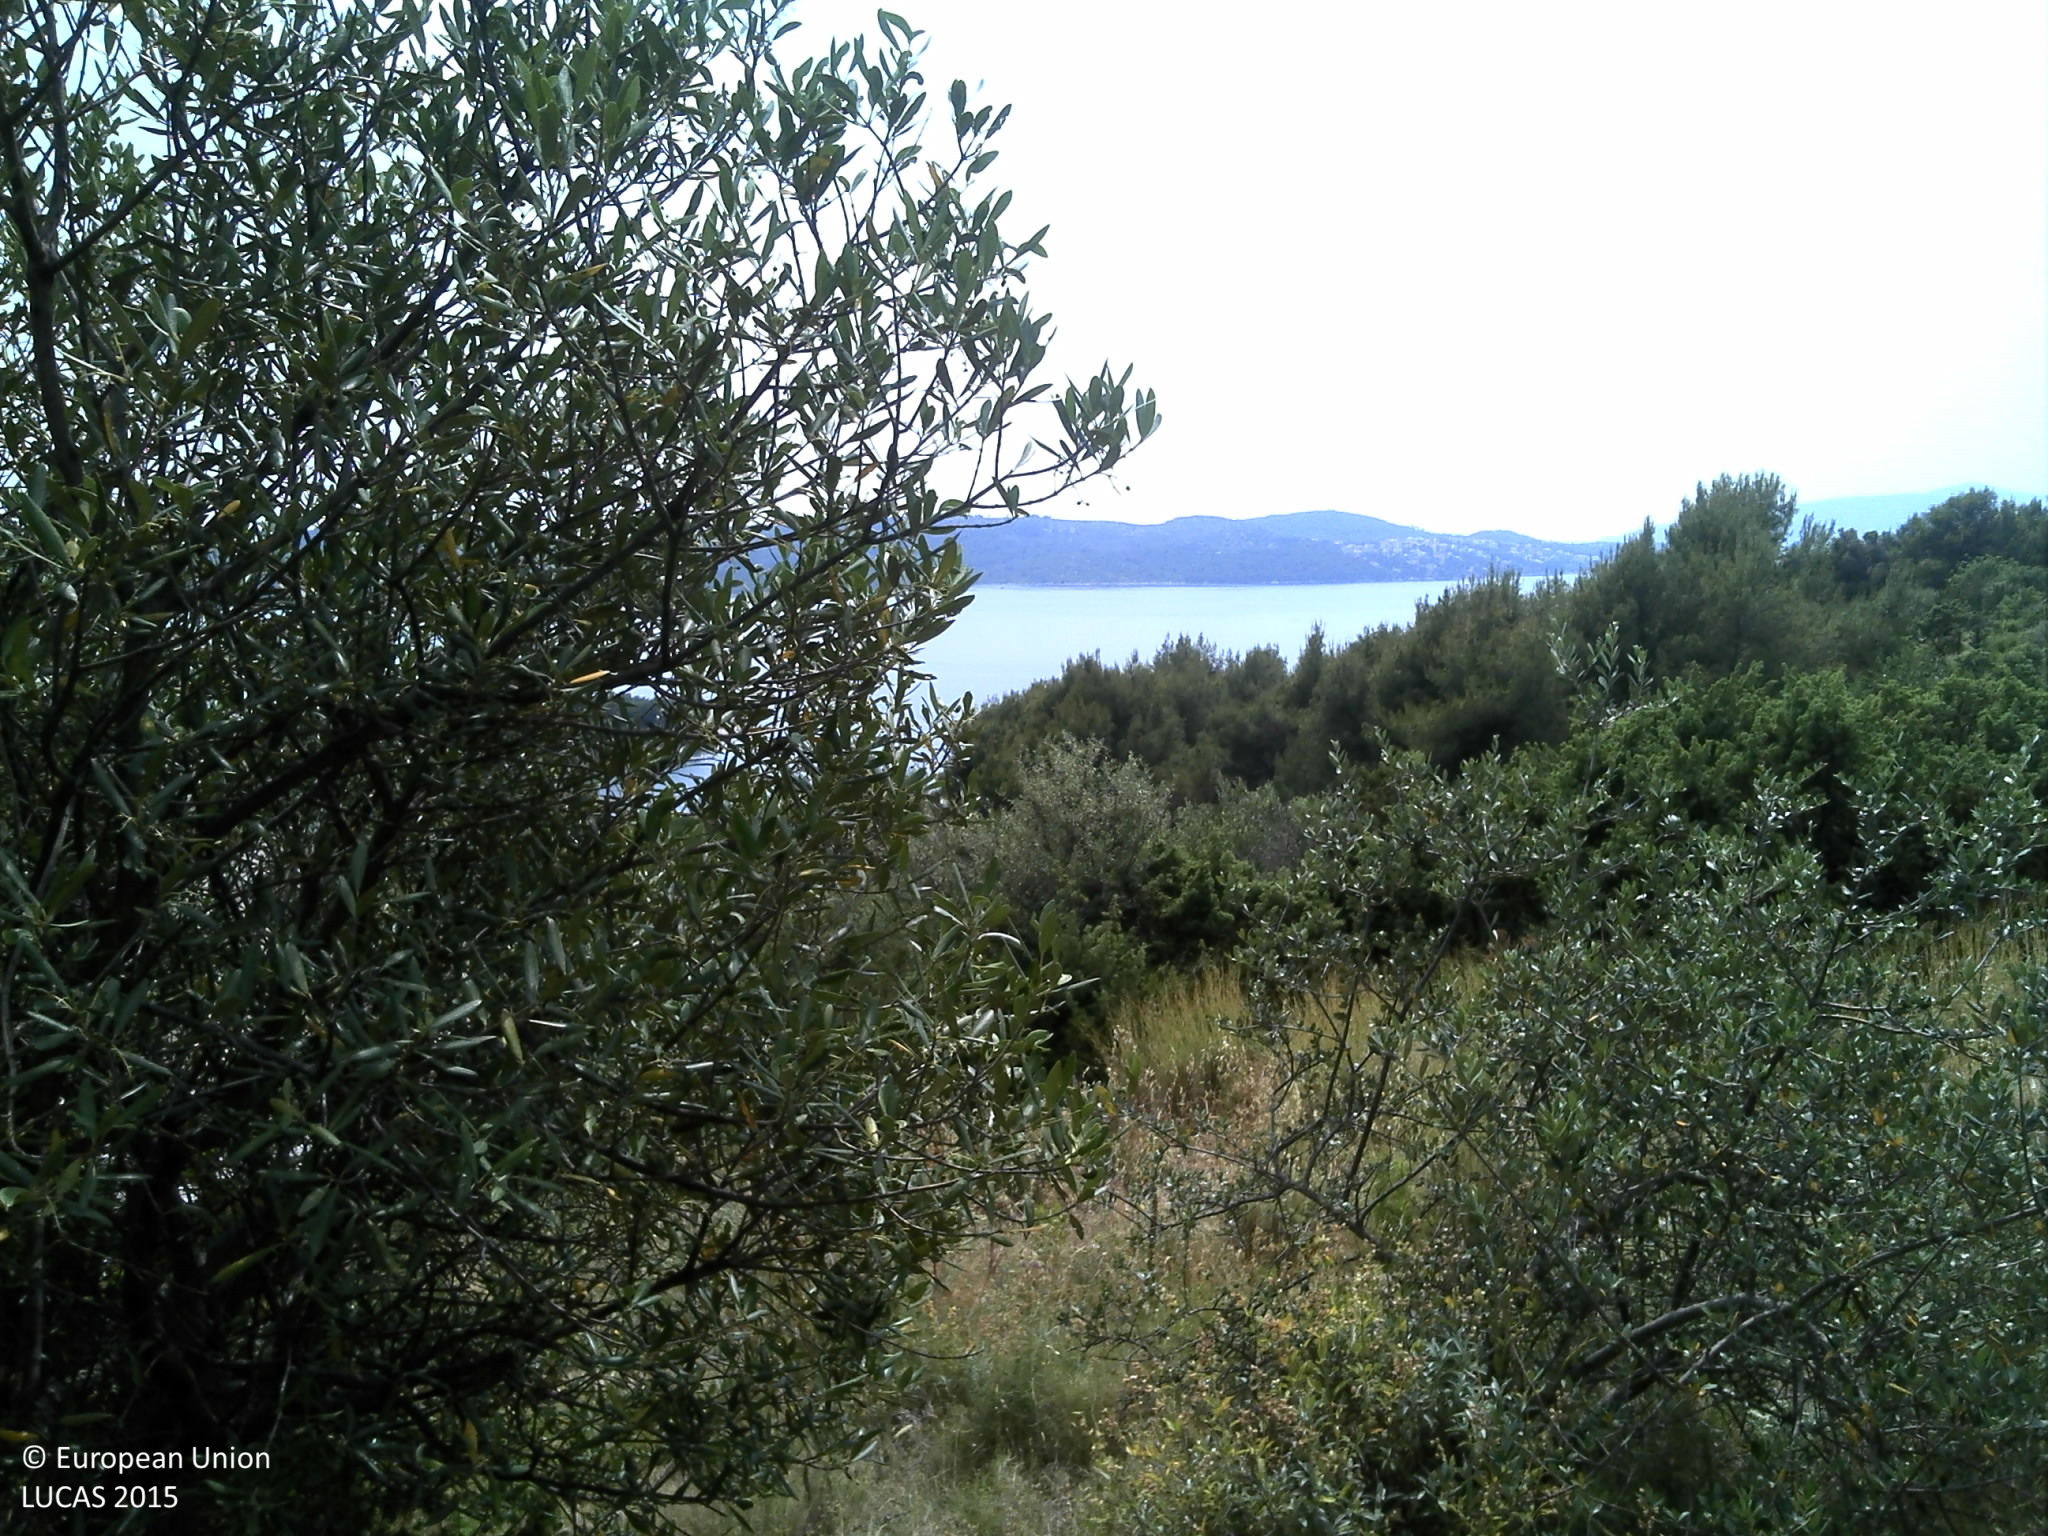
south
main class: Cropland
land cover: Olive groves
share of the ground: 25 - 50 %
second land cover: Spontaneously vegetated surfaces
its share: 50 - 75 %
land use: Kitchen garden
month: June
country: HR
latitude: 43.5101
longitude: 16.2619
